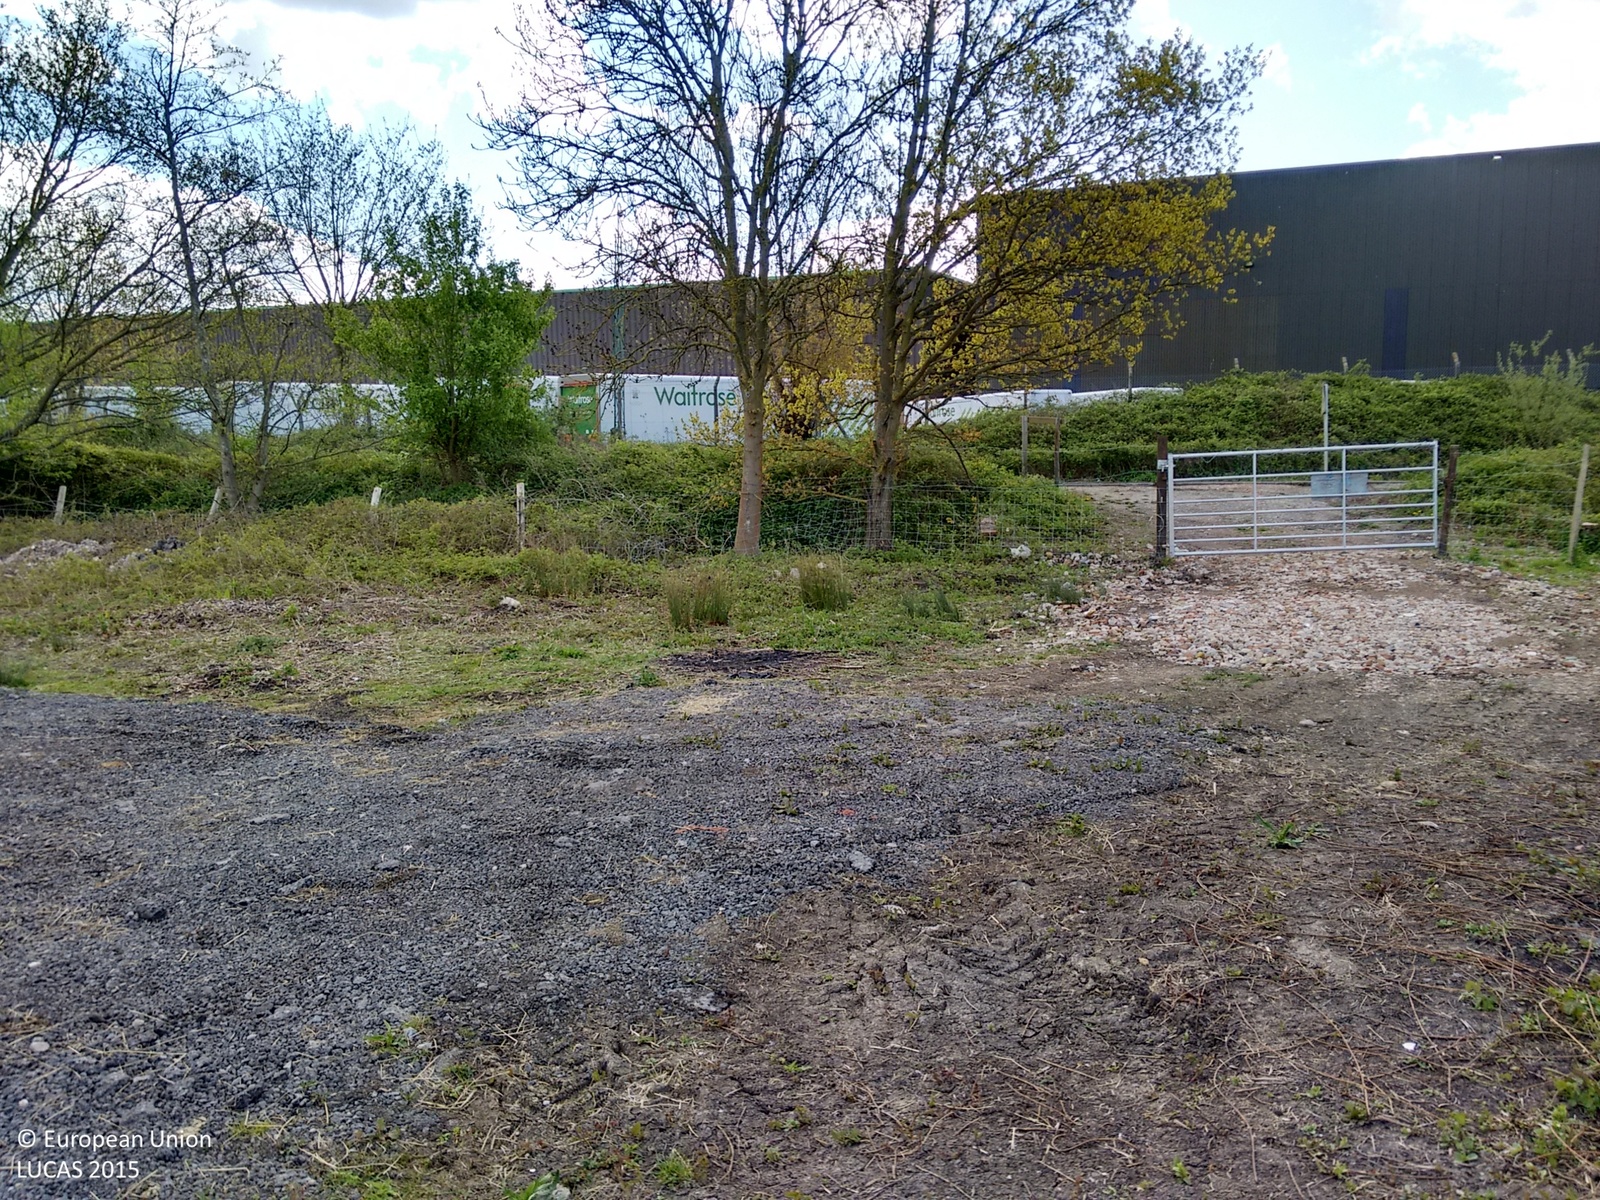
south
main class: Grassland
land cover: Grassland without tree/shrub cover
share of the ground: > 75 %
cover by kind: herbaceous plants 100 %
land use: Agriculture (excluding fallow land and kitchen gardens)
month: April
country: GB
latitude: 51.3069
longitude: 0.4901
